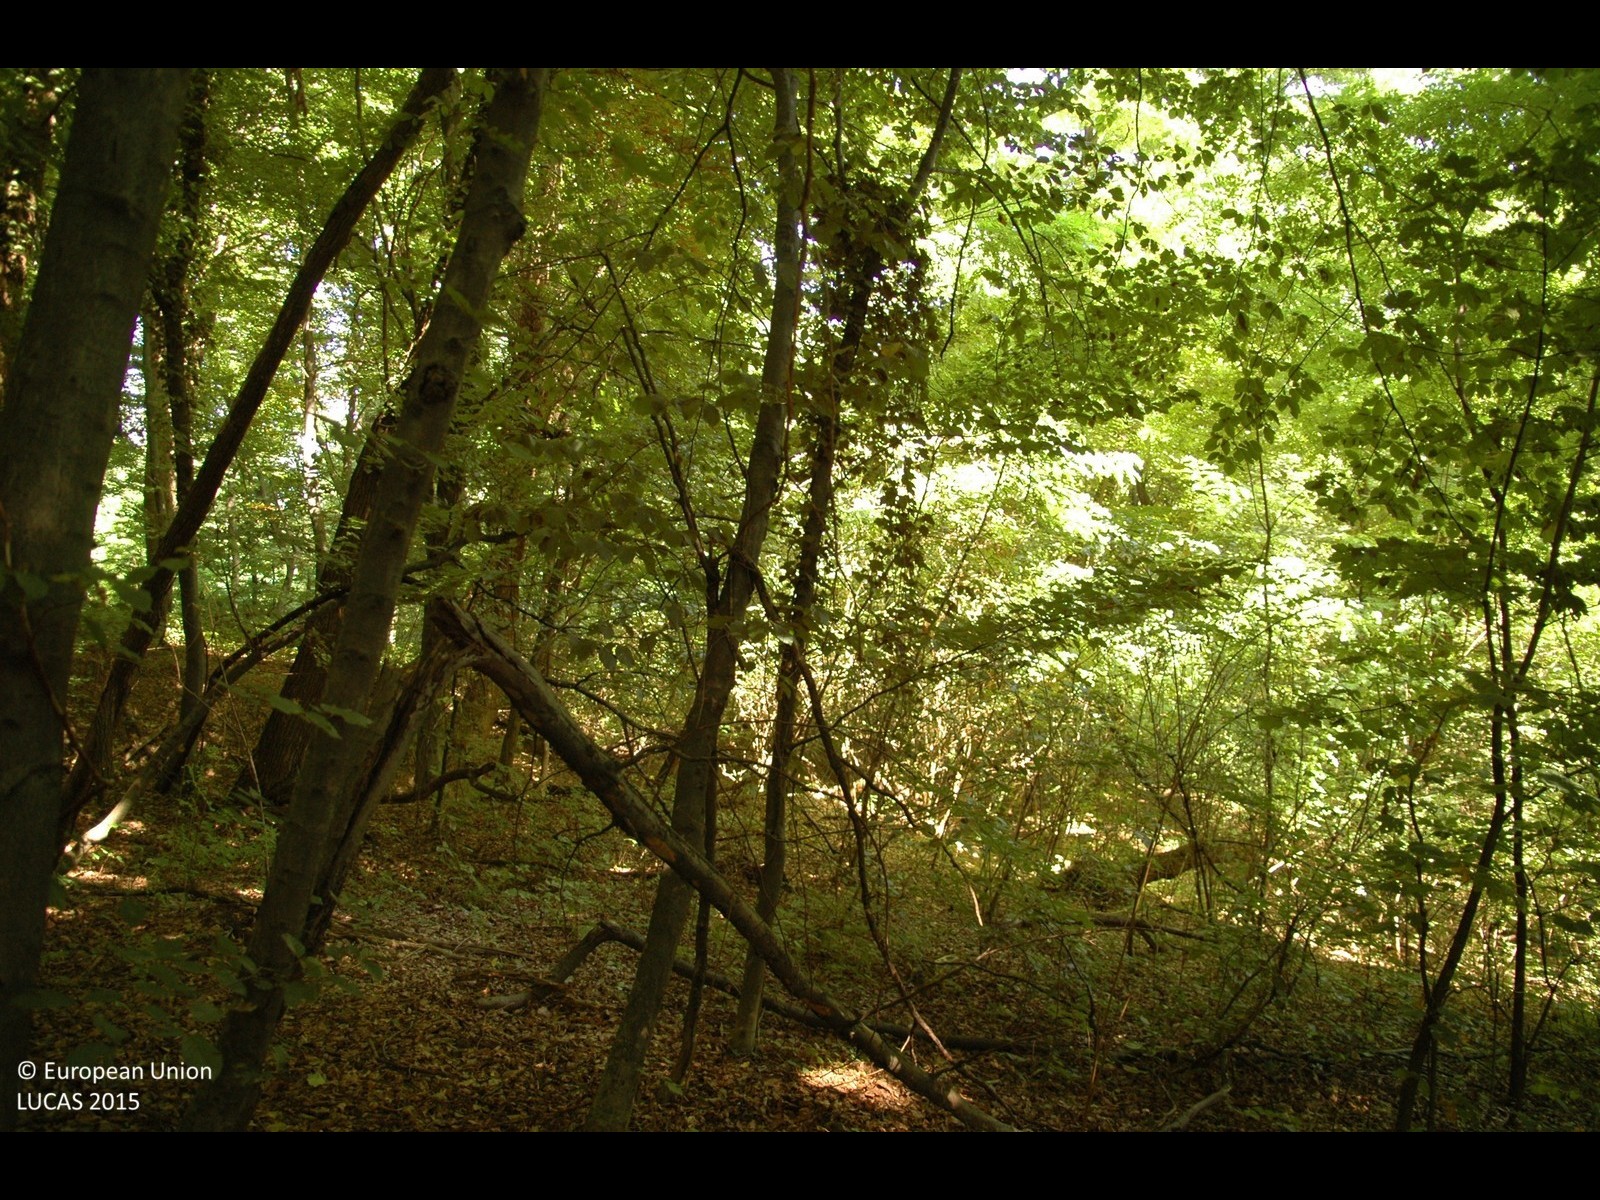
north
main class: Woodland
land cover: Broadleaved woodland
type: beech forest
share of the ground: > 75 %
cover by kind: broadleaved forest trees 100 %
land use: Forestry
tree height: > 5 m
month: August
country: HR
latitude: 46.1757
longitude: 16.7238
